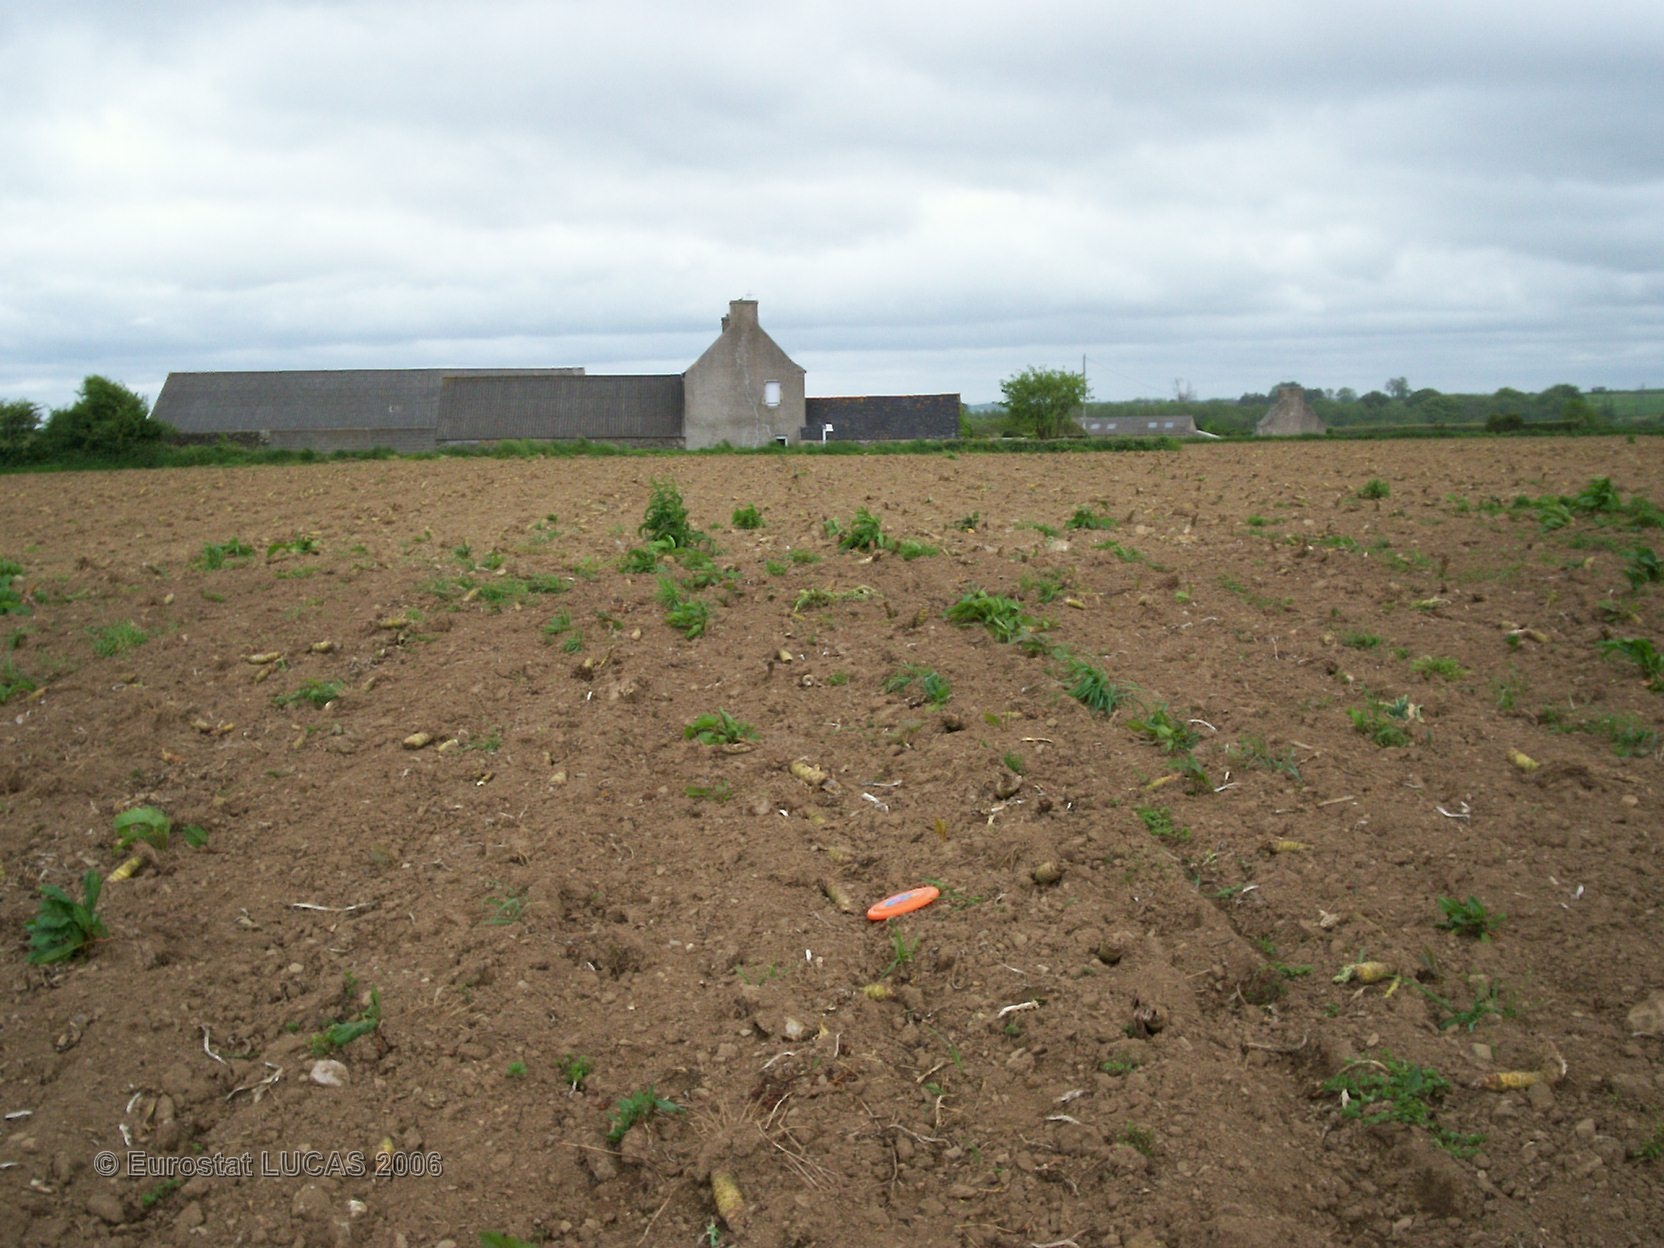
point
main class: Bare land
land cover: Bare land
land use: Agriculture (excluding fallow land and kitchen gardens)
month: May
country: FR
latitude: 48.6588
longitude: -3.7003
